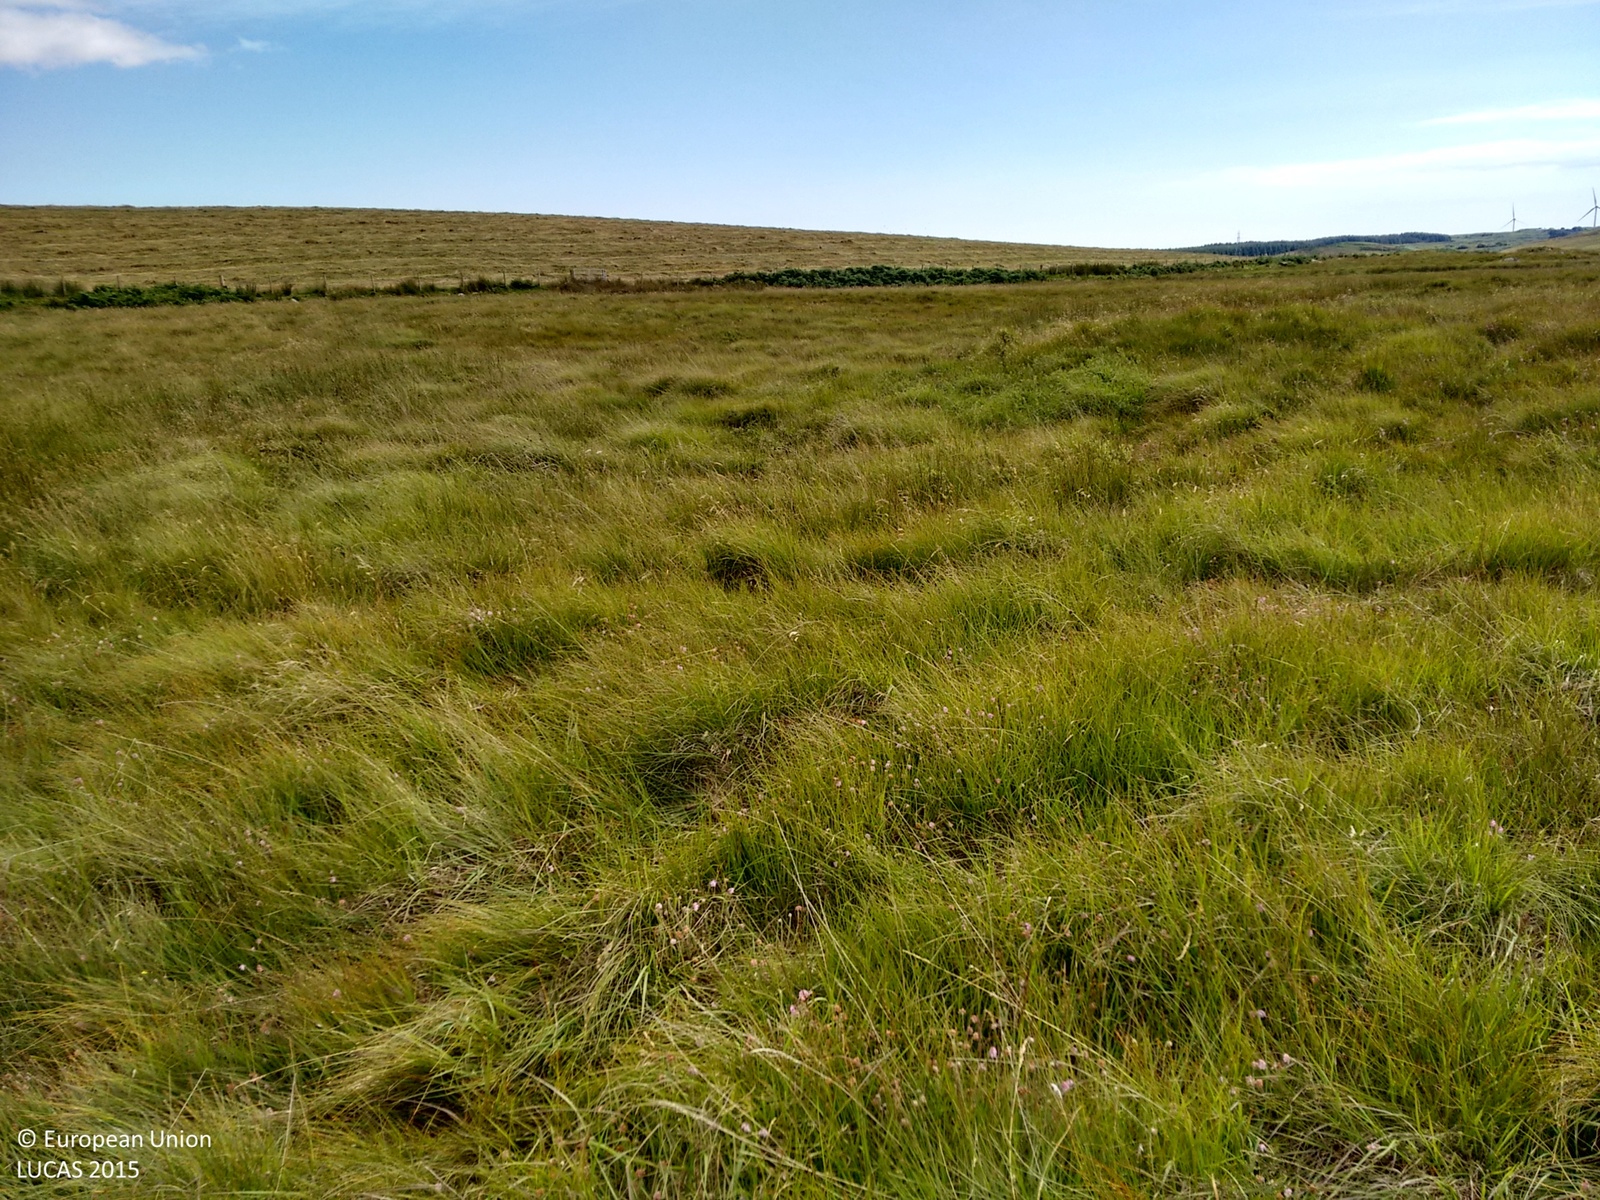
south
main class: Grassland
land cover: Grassland without tree/shrub cover
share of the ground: > 75 %
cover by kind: herbaceous plants 100 %
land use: Agriculture (excluding fallow land and kitchen gardens)
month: August
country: GB
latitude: 54.9070
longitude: -4.7533
